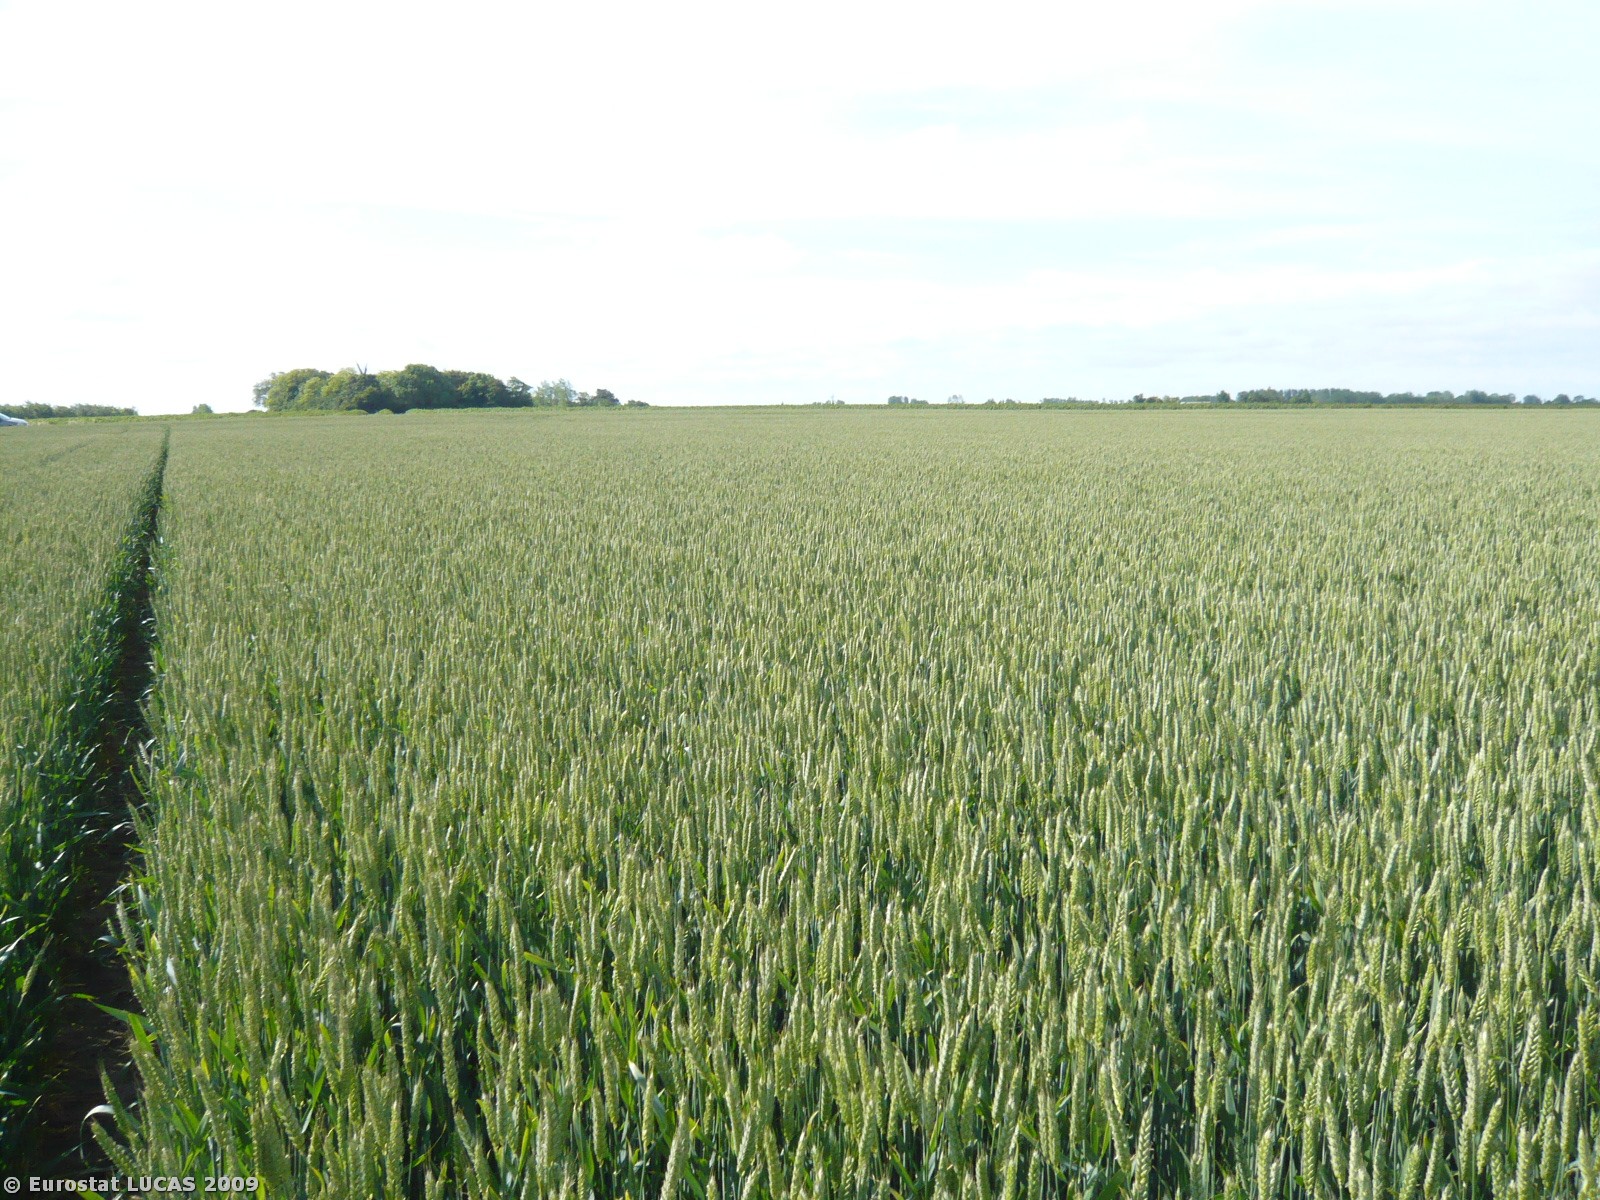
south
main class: Cropland
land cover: Common wheat
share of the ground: > 75 %
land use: Agriculture (excluding fallow land and kitchen gardens)
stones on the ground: < 10 %
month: June
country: DK
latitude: 54.9244
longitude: 11.1382
